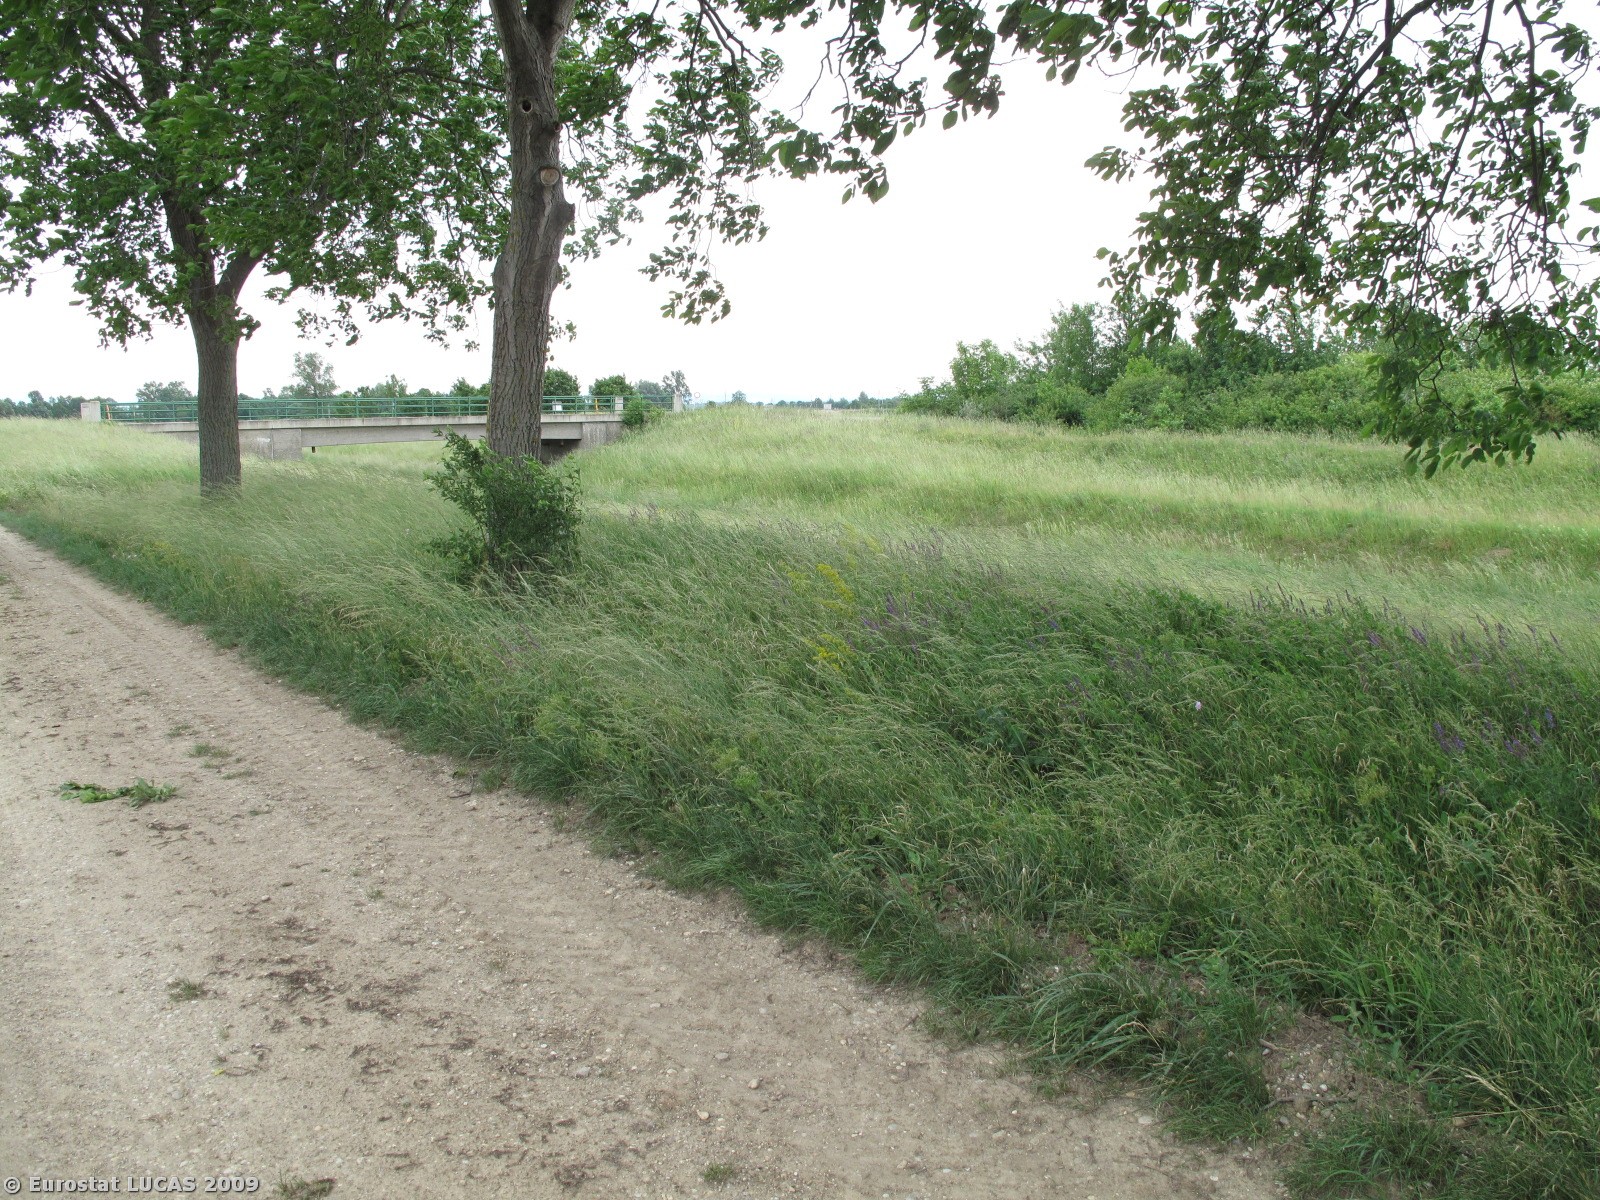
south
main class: Cropland
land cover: Common wheat
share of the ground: > 75 %
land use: Agriculture (excluding fallow land and kitchen gardens)
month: May
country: AT
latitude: 48.4021
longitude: 16.0151
